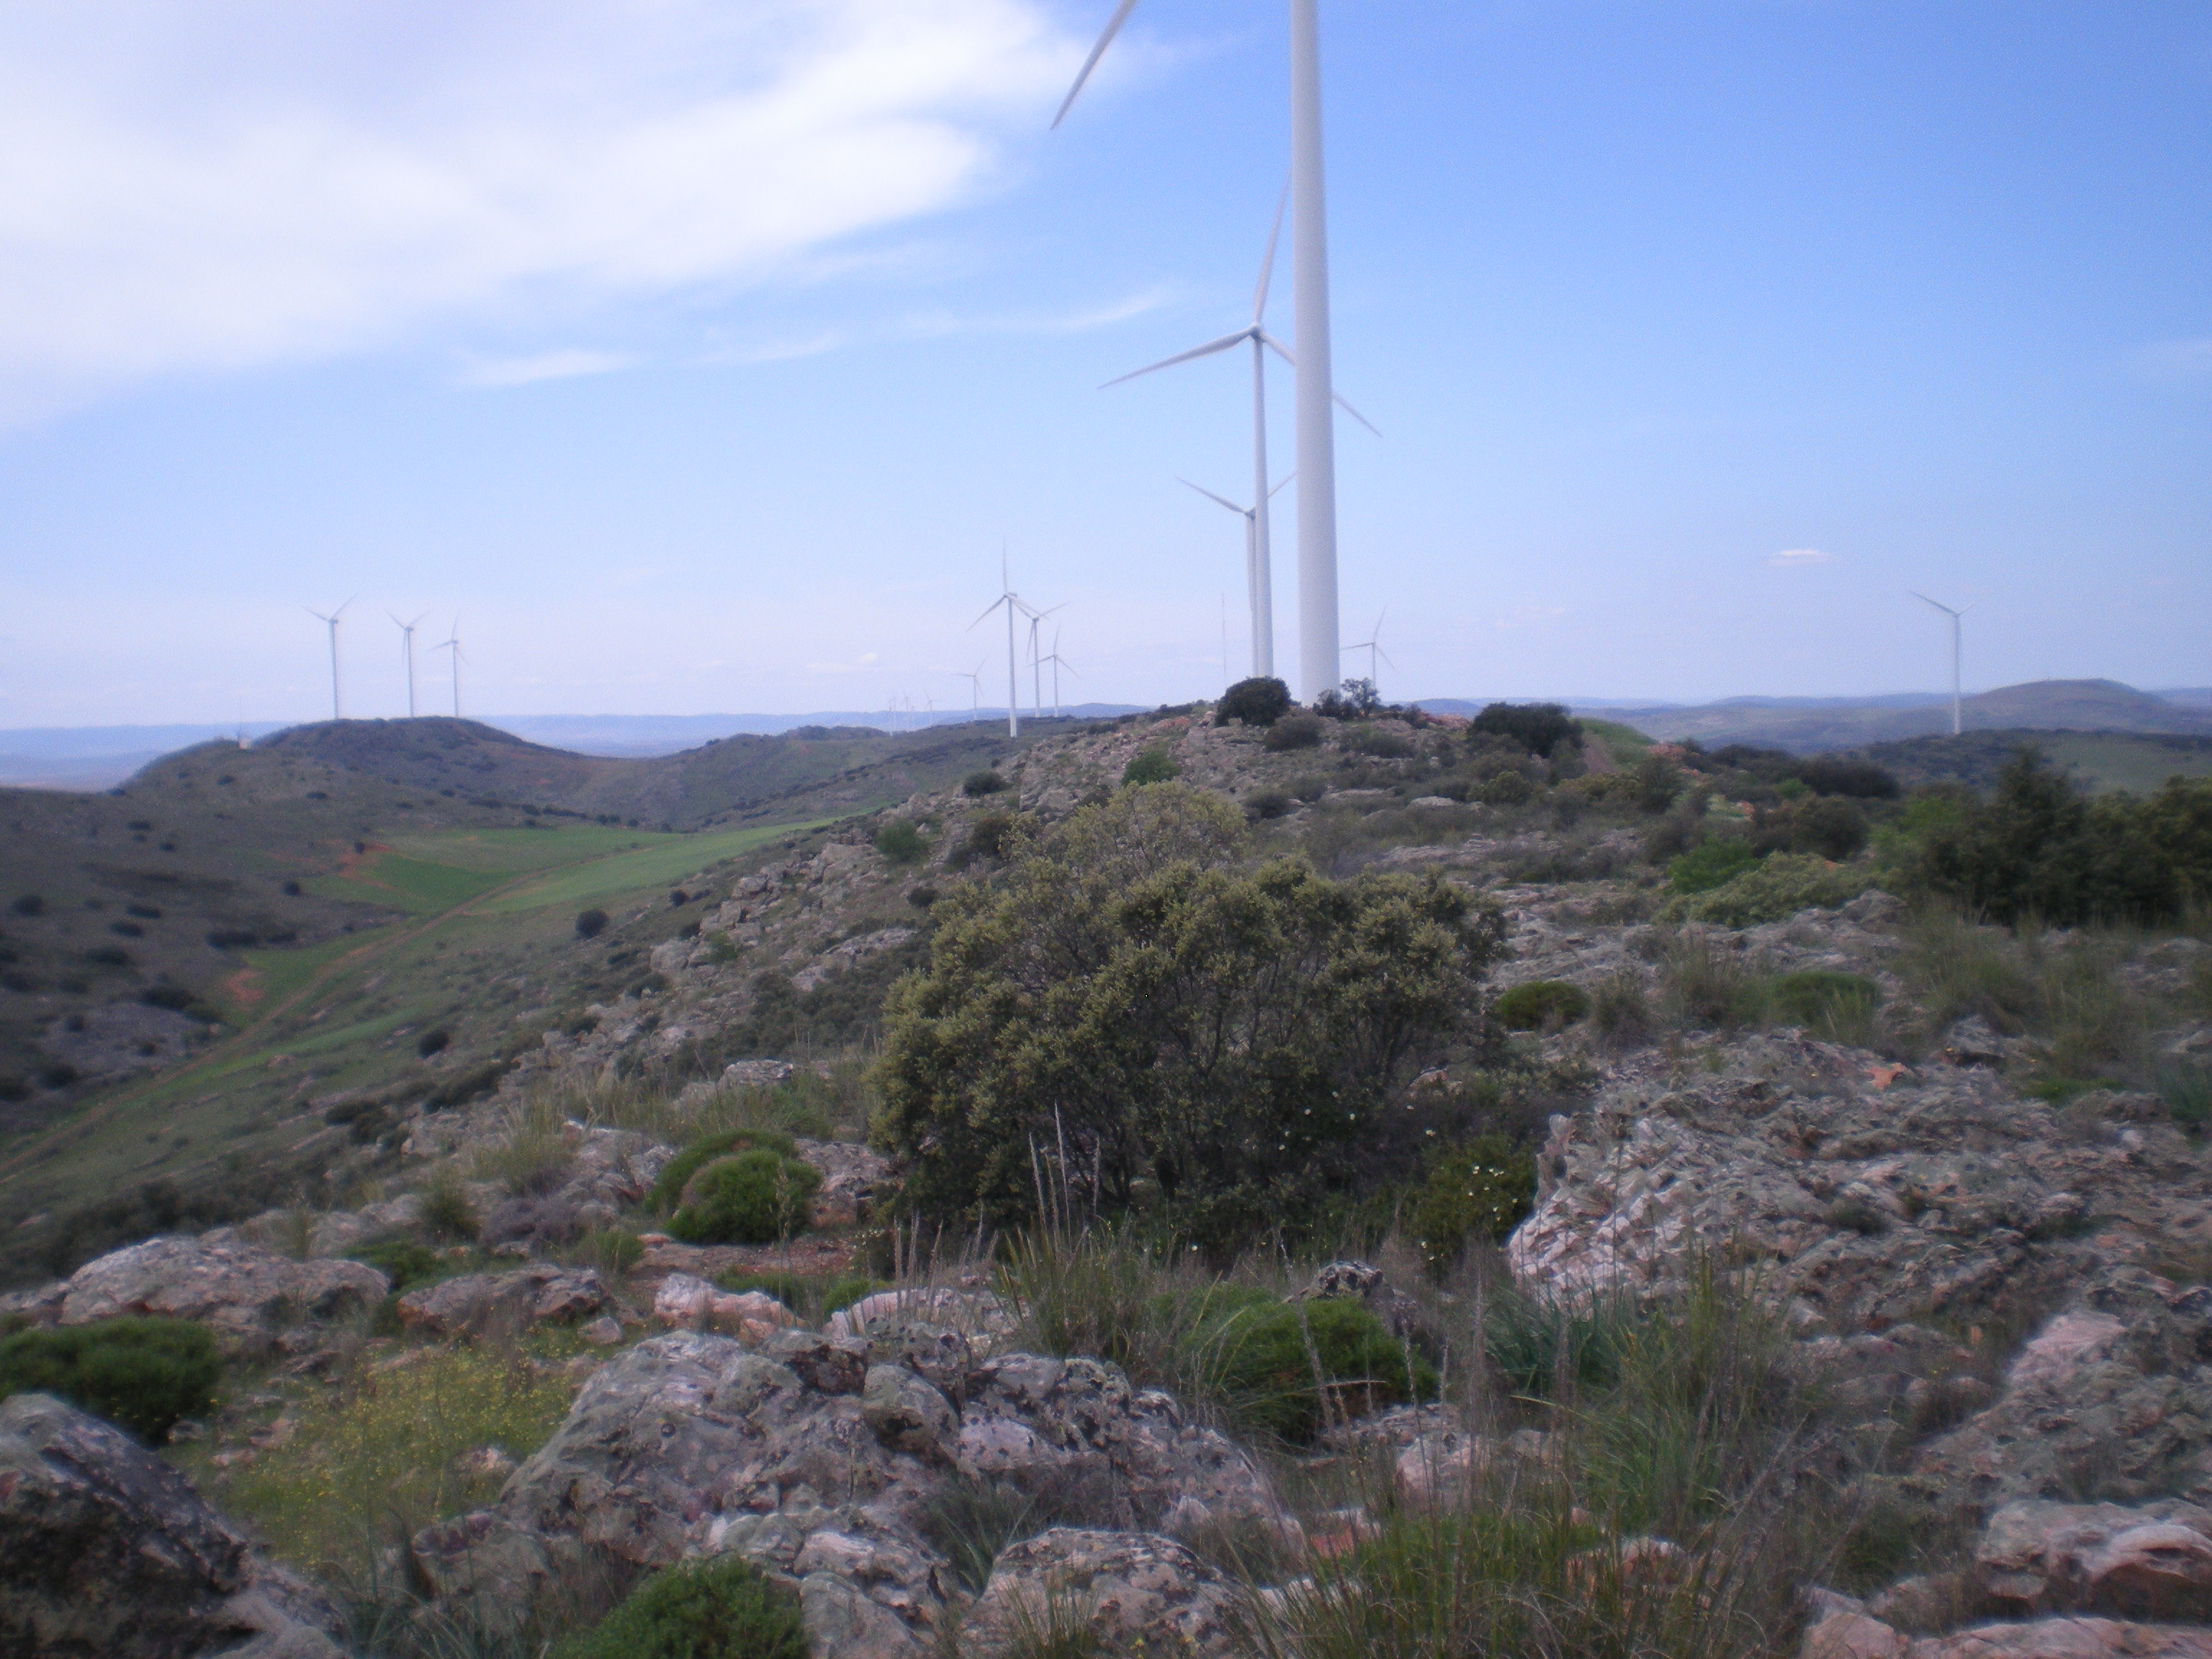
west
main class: Shrubland
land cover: Shrubland without tree cover
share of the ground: 10 - 25 %
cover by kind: herbaceous plants 50 %, consolidated bare surface 40 %, shrubs 10 %
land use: Semi-natural and natural areas not in use
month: April
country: ES
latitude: 38.8425
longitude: -3.5747
